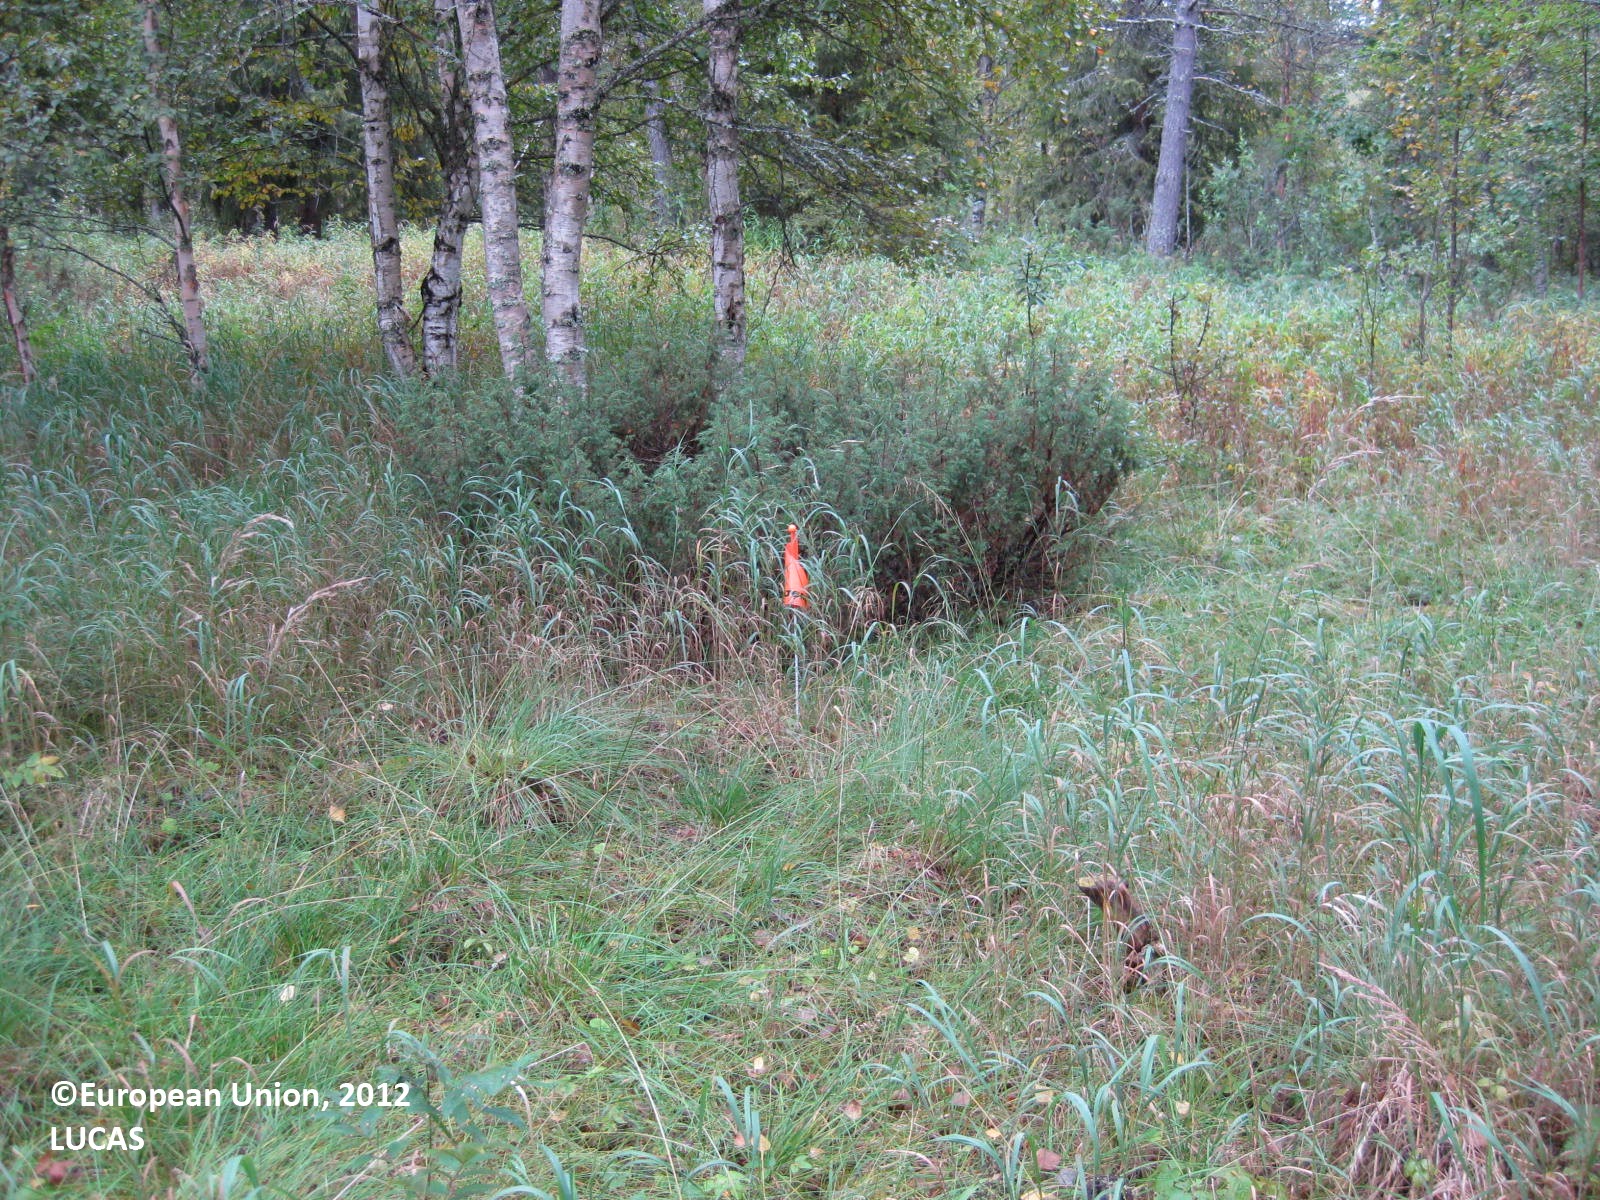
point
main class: Woodland
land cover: Pine dominated mixed woodland
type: boreal forest
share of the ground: 50 - 75 %
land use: Forestry
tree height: > 5 m
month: August
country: FI
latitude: 66.0889
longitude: 28.7560
